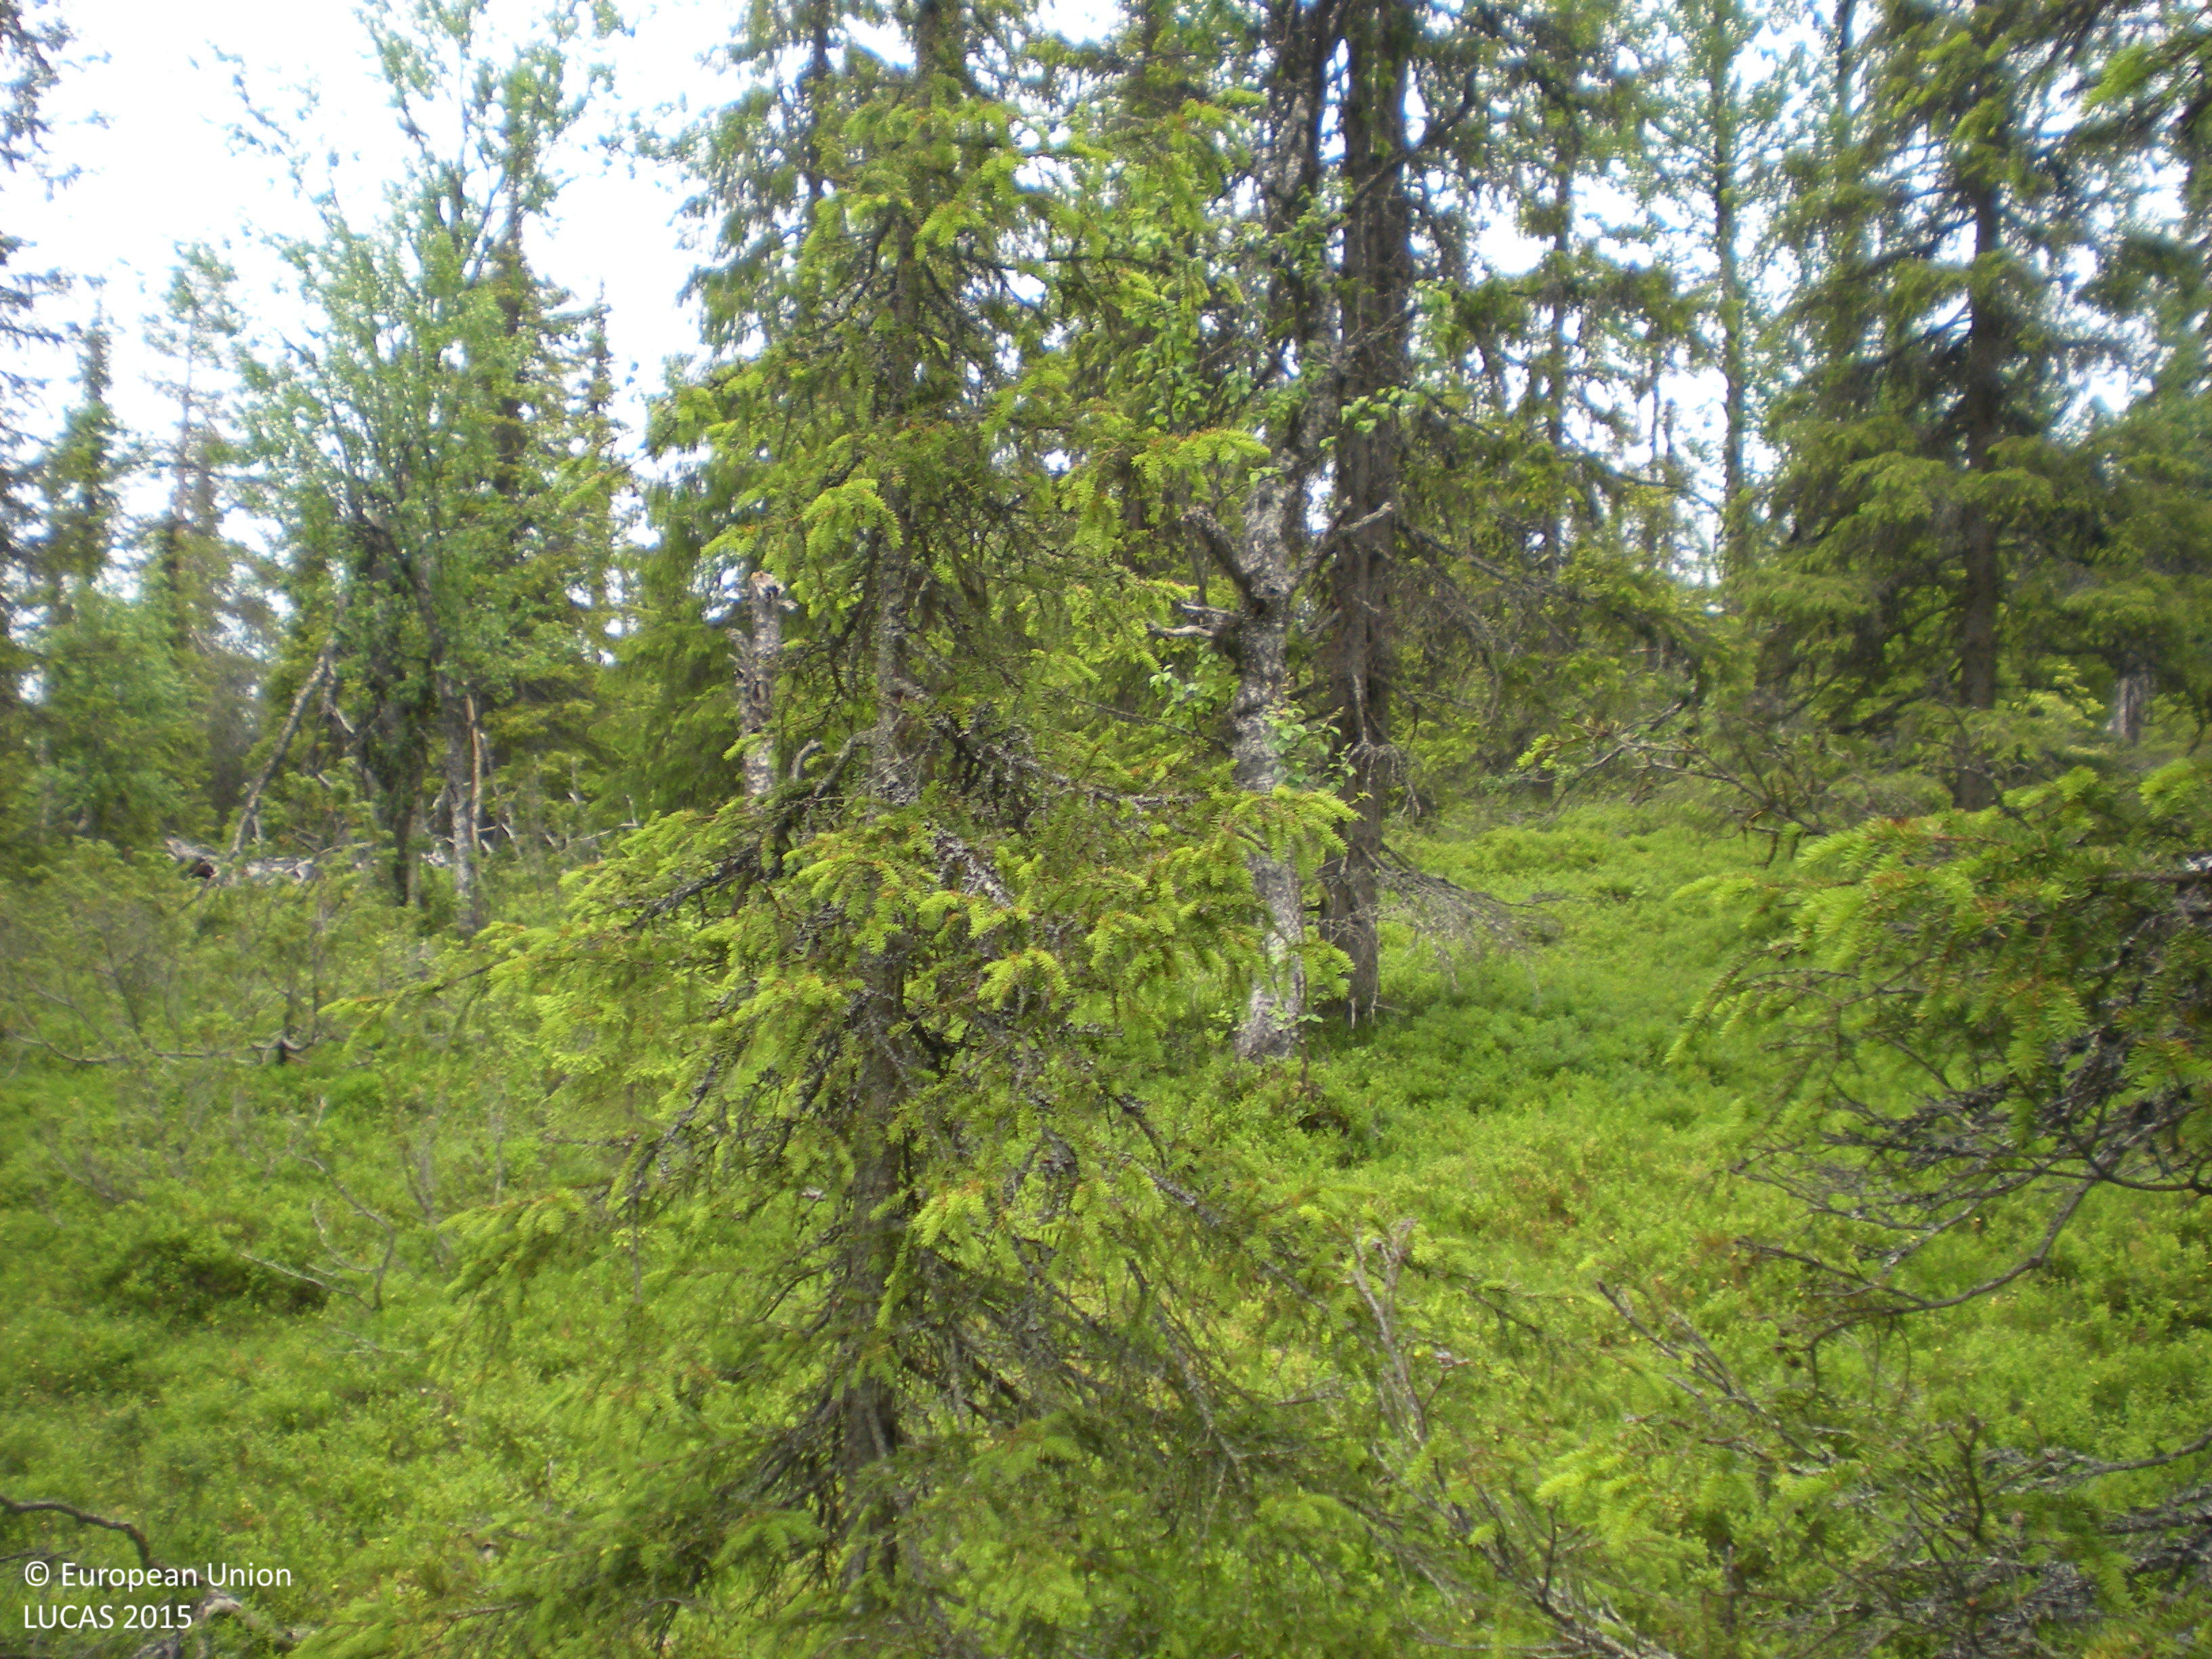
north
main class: Woodland
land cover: Spruce dominated mixed woodland
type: boreal forest
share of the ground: 50 - 75 %
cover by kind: coniferous forest trees 50 %, broadleaved forest trees 20 %, shrubs 20 %, herbaceous plants 5 %, lichens and mosses 5 %
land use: Forestry
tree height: > 5 m
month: July
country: SE
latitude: 65.9297
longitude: 18.2399
